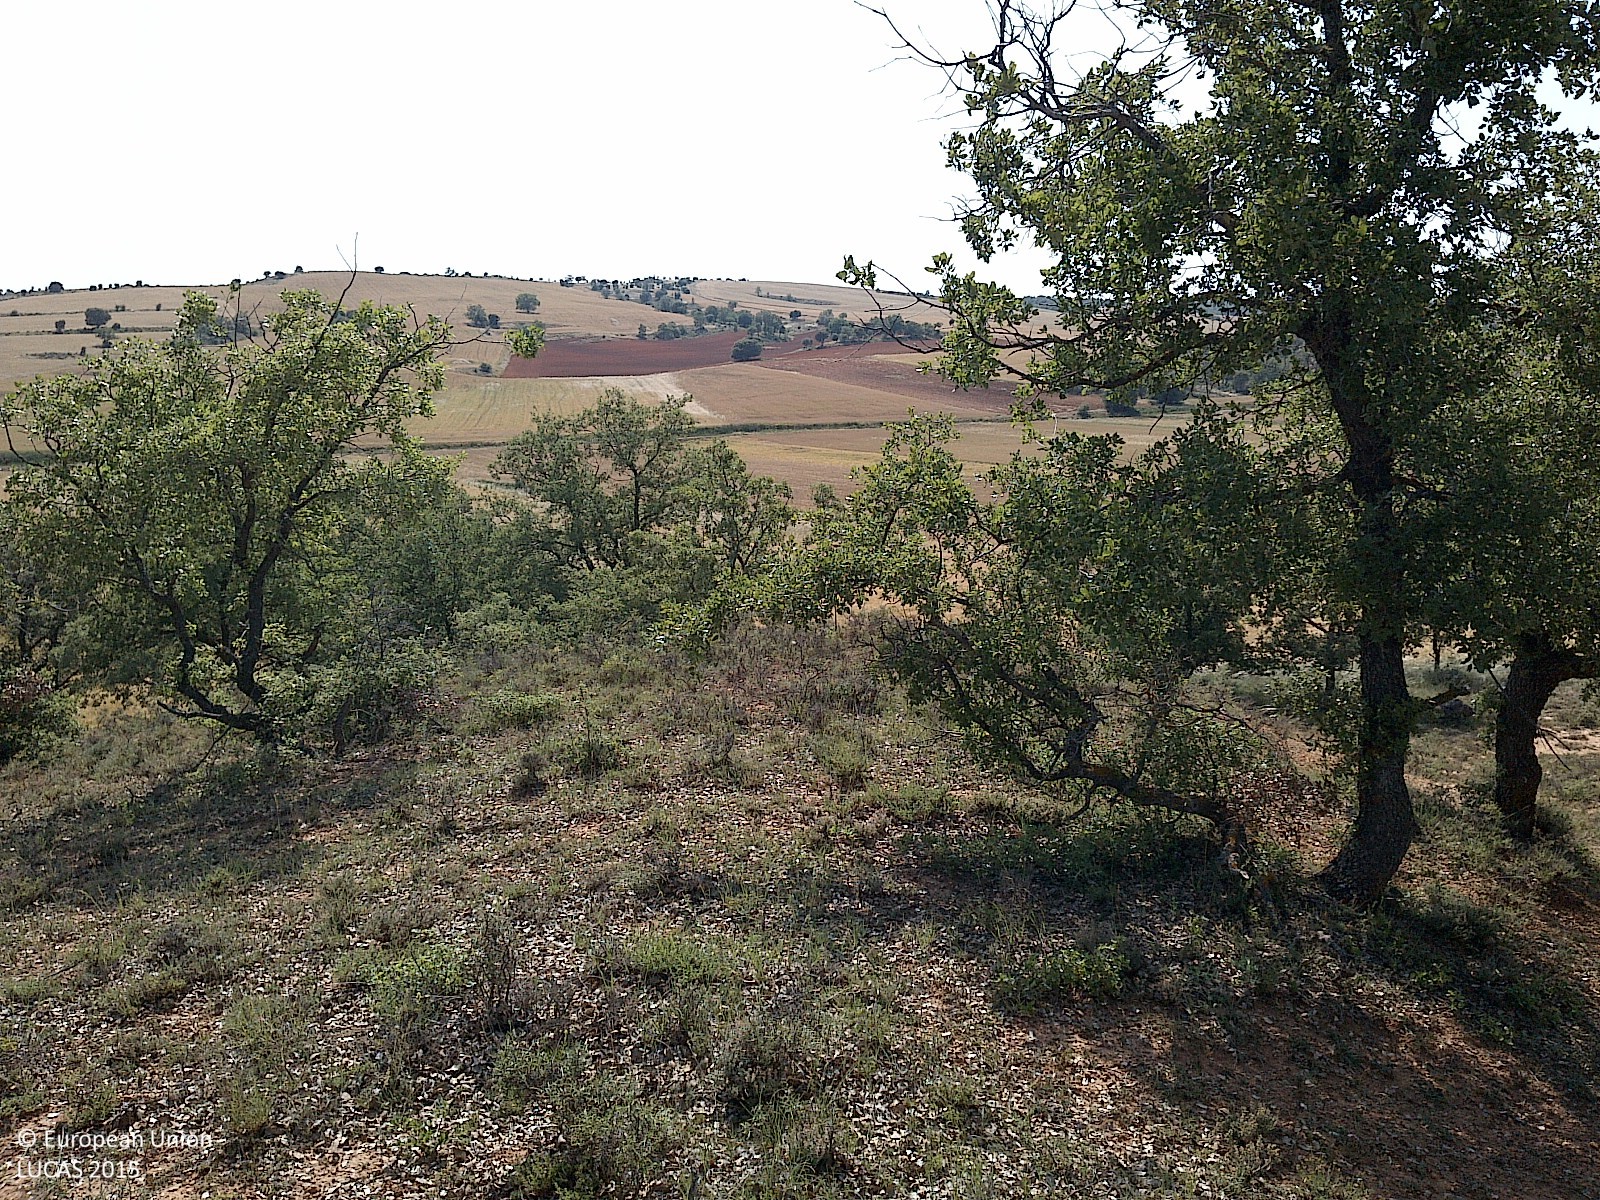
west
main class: Woodland
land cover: Broadleaved woodland
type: broadleaved evergreen forest
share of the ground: 25 - 50 %
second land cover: Grassland without tree/shrub cover
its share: 50 - 75 %
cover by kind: herbaceous plants 50 %, broadleaved forest trees 30 %, shrubs 10 %, unconsolidated bare surface 10 %
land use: Forestry
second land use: Agriculture (excluding fallow land and kitchen gardens)
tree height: < 5 m
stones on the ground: < 10 %
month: June
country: ES
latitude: 41.5426
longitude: -2.2483
